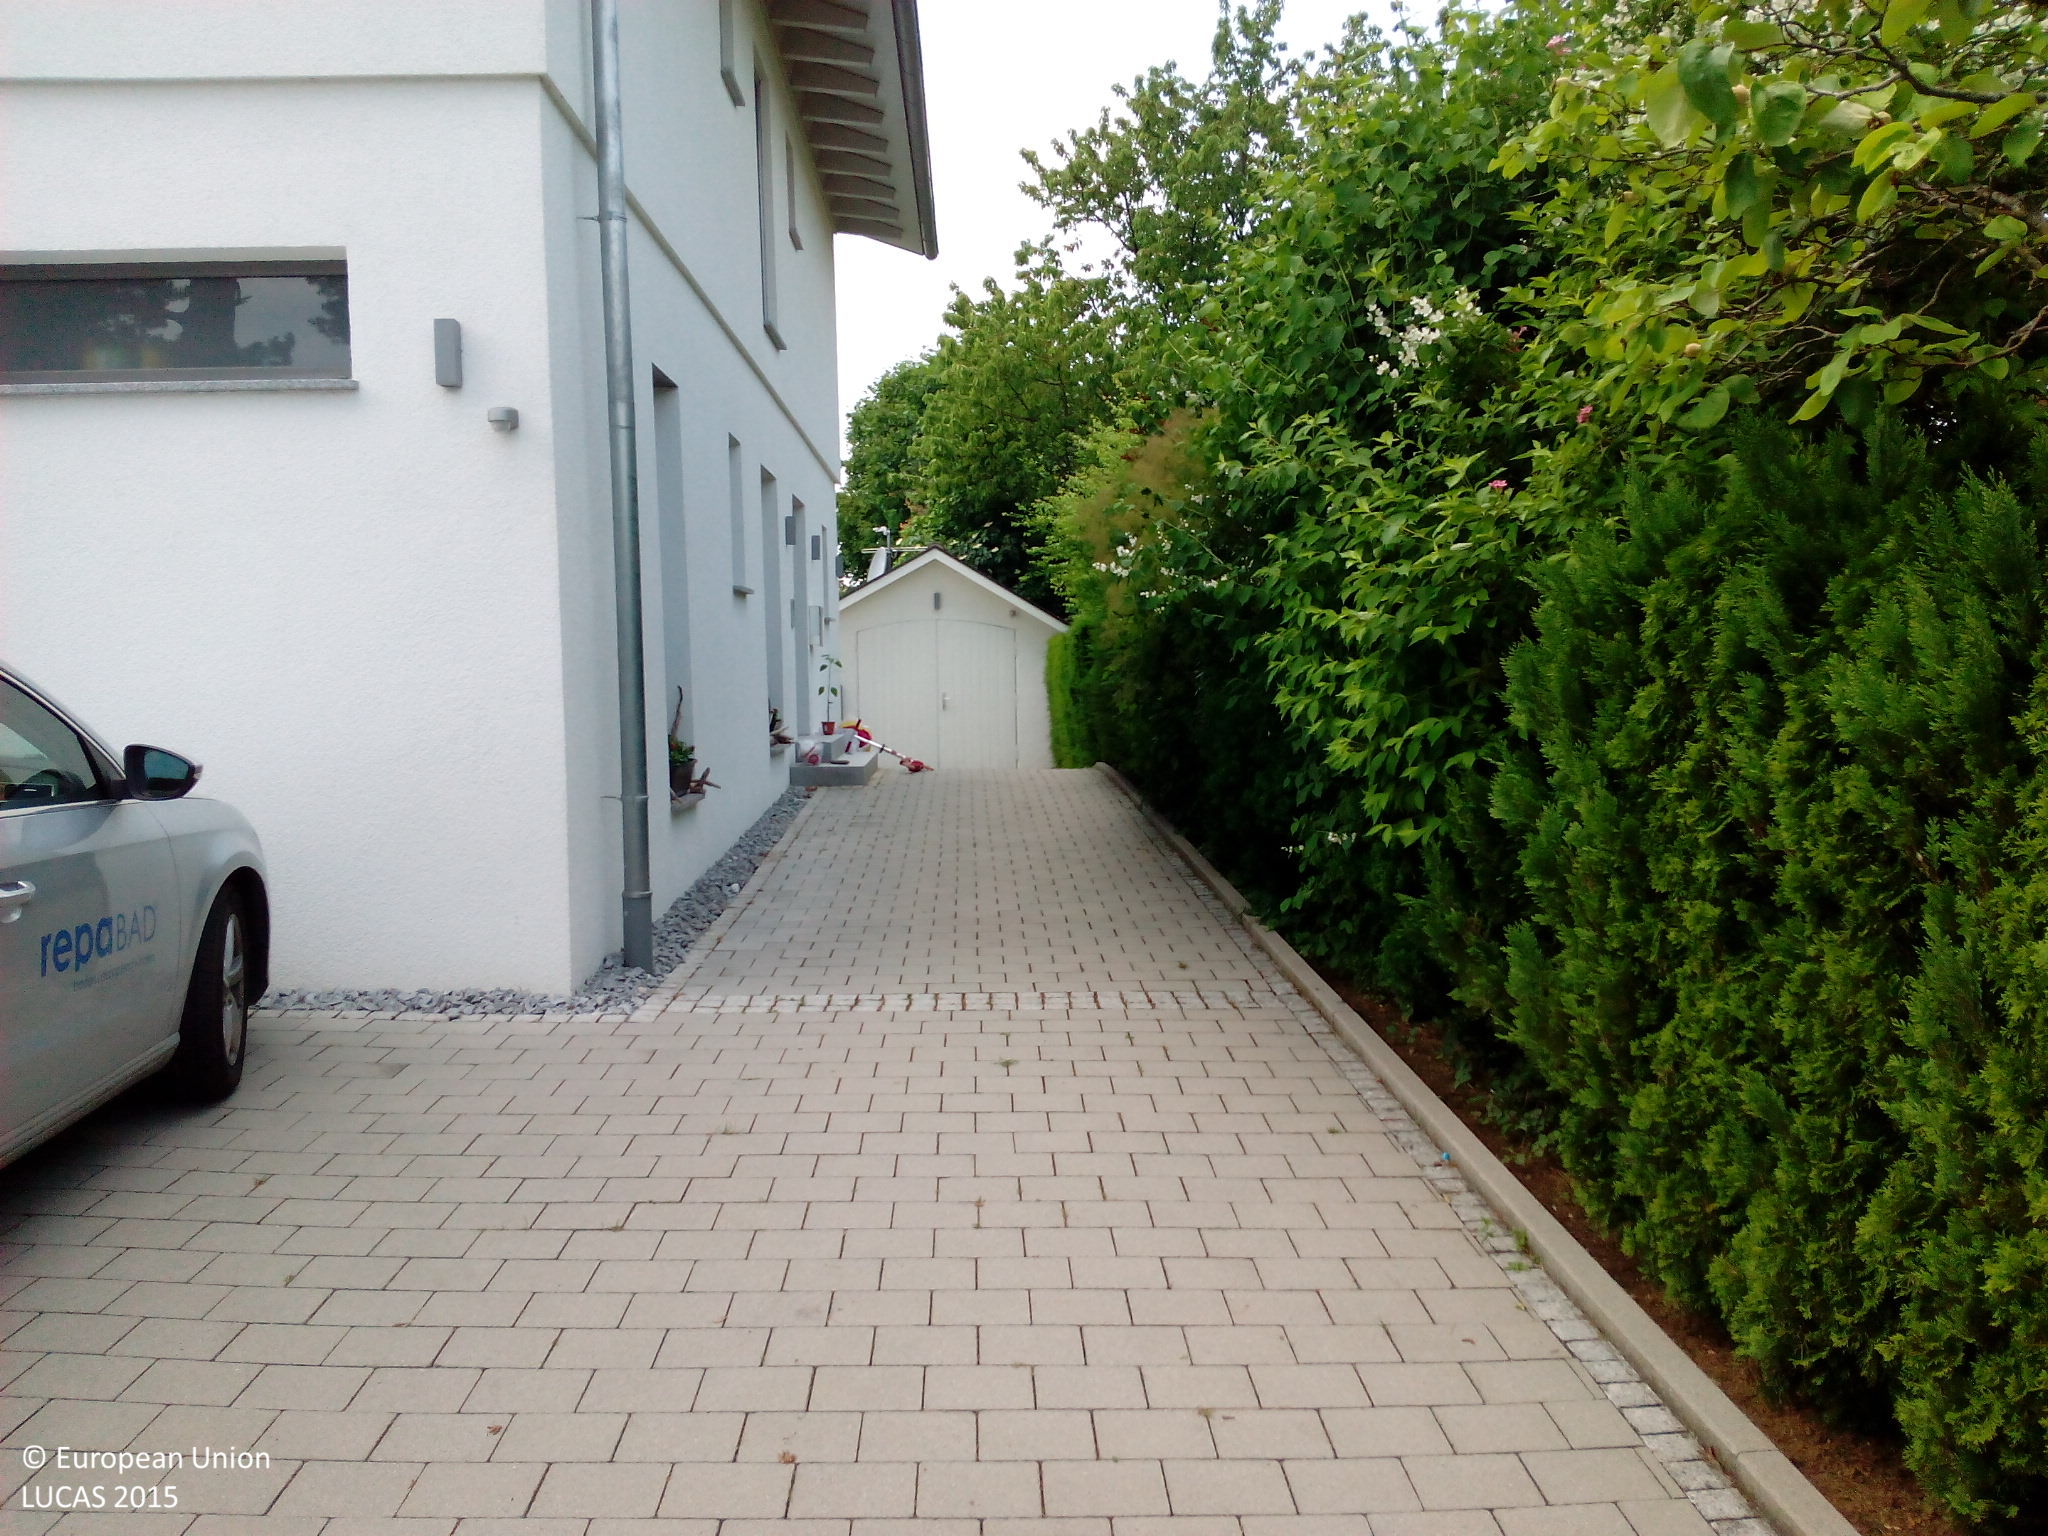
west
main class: Woodland
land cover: Broadleaved woodland
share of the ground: 50 - 75 %
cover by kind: broadleaved forest trees 55 %, herbaceous plants 40 %, shrubs 5 %
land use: Residential
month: June
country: DE
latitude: 48.6367
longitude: 9.6067
